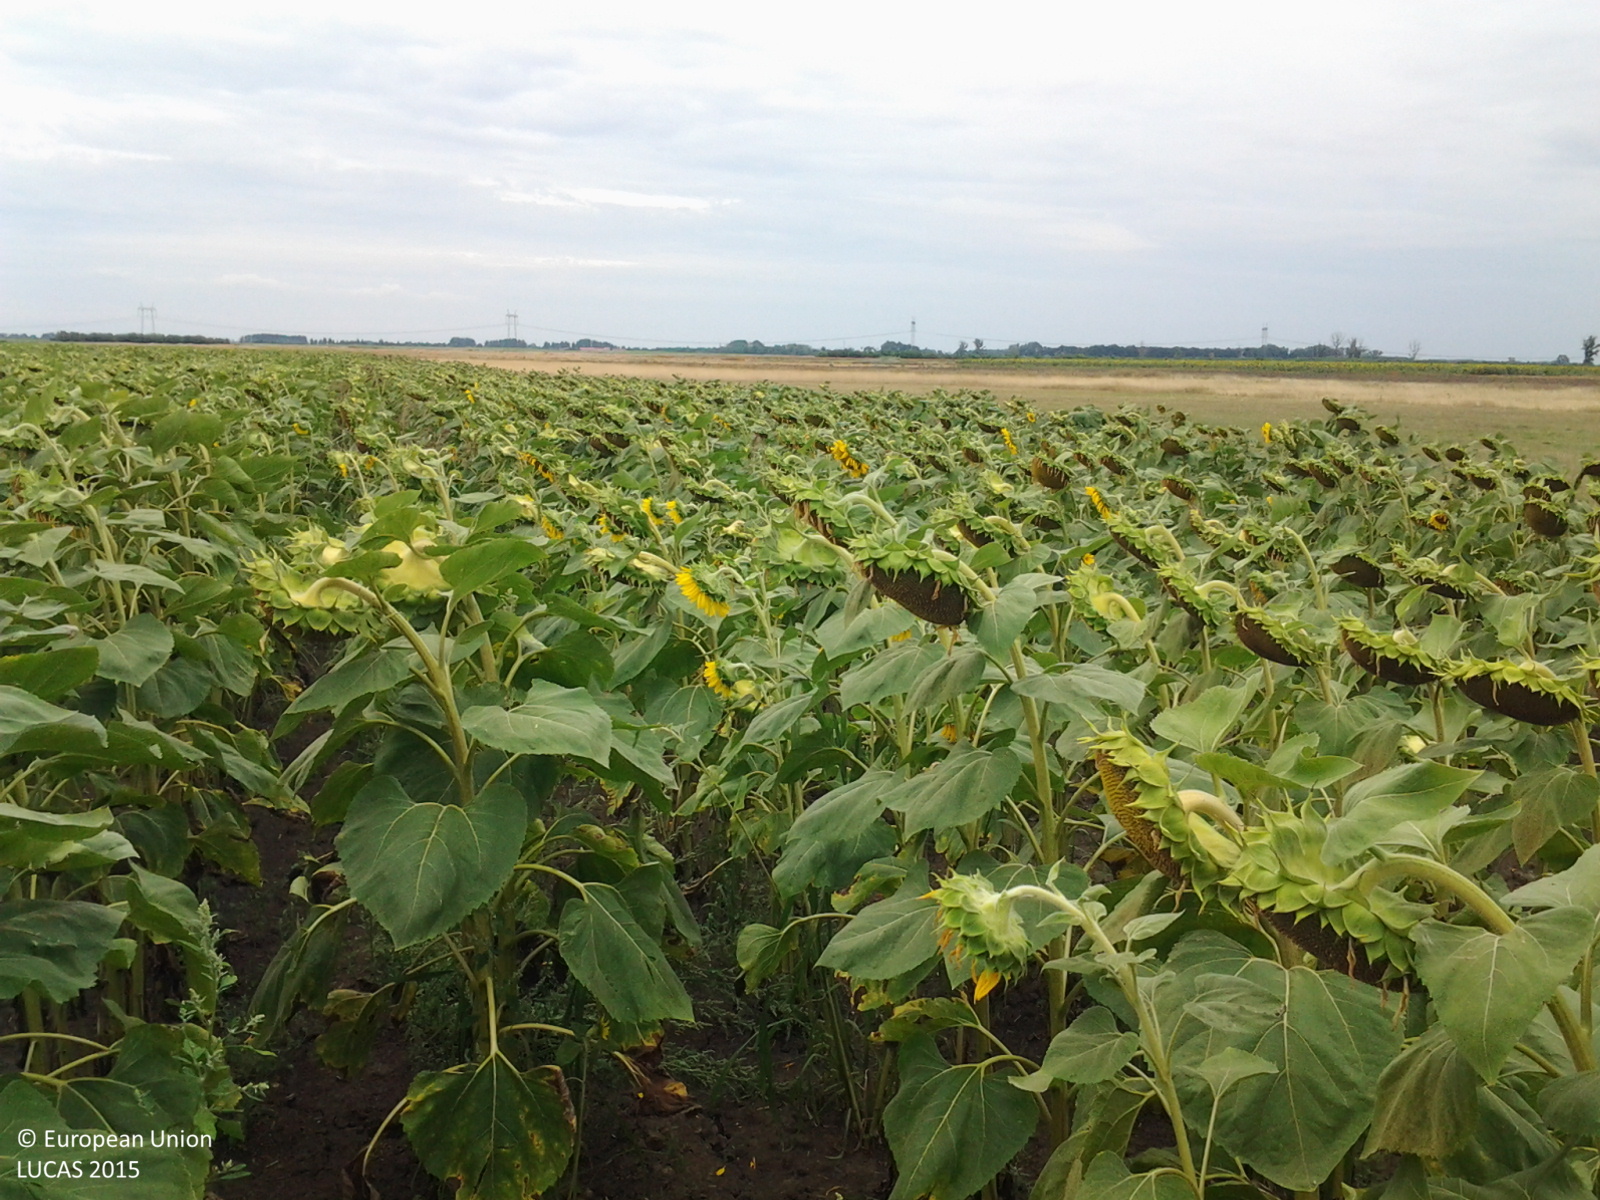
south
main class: Cropland
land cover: Sunflower
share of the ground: > 75 %
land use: Agriculture (excluding fallow land and kitchen gardens)
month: July
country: HU
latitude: 47.3016
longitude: 20.5182
